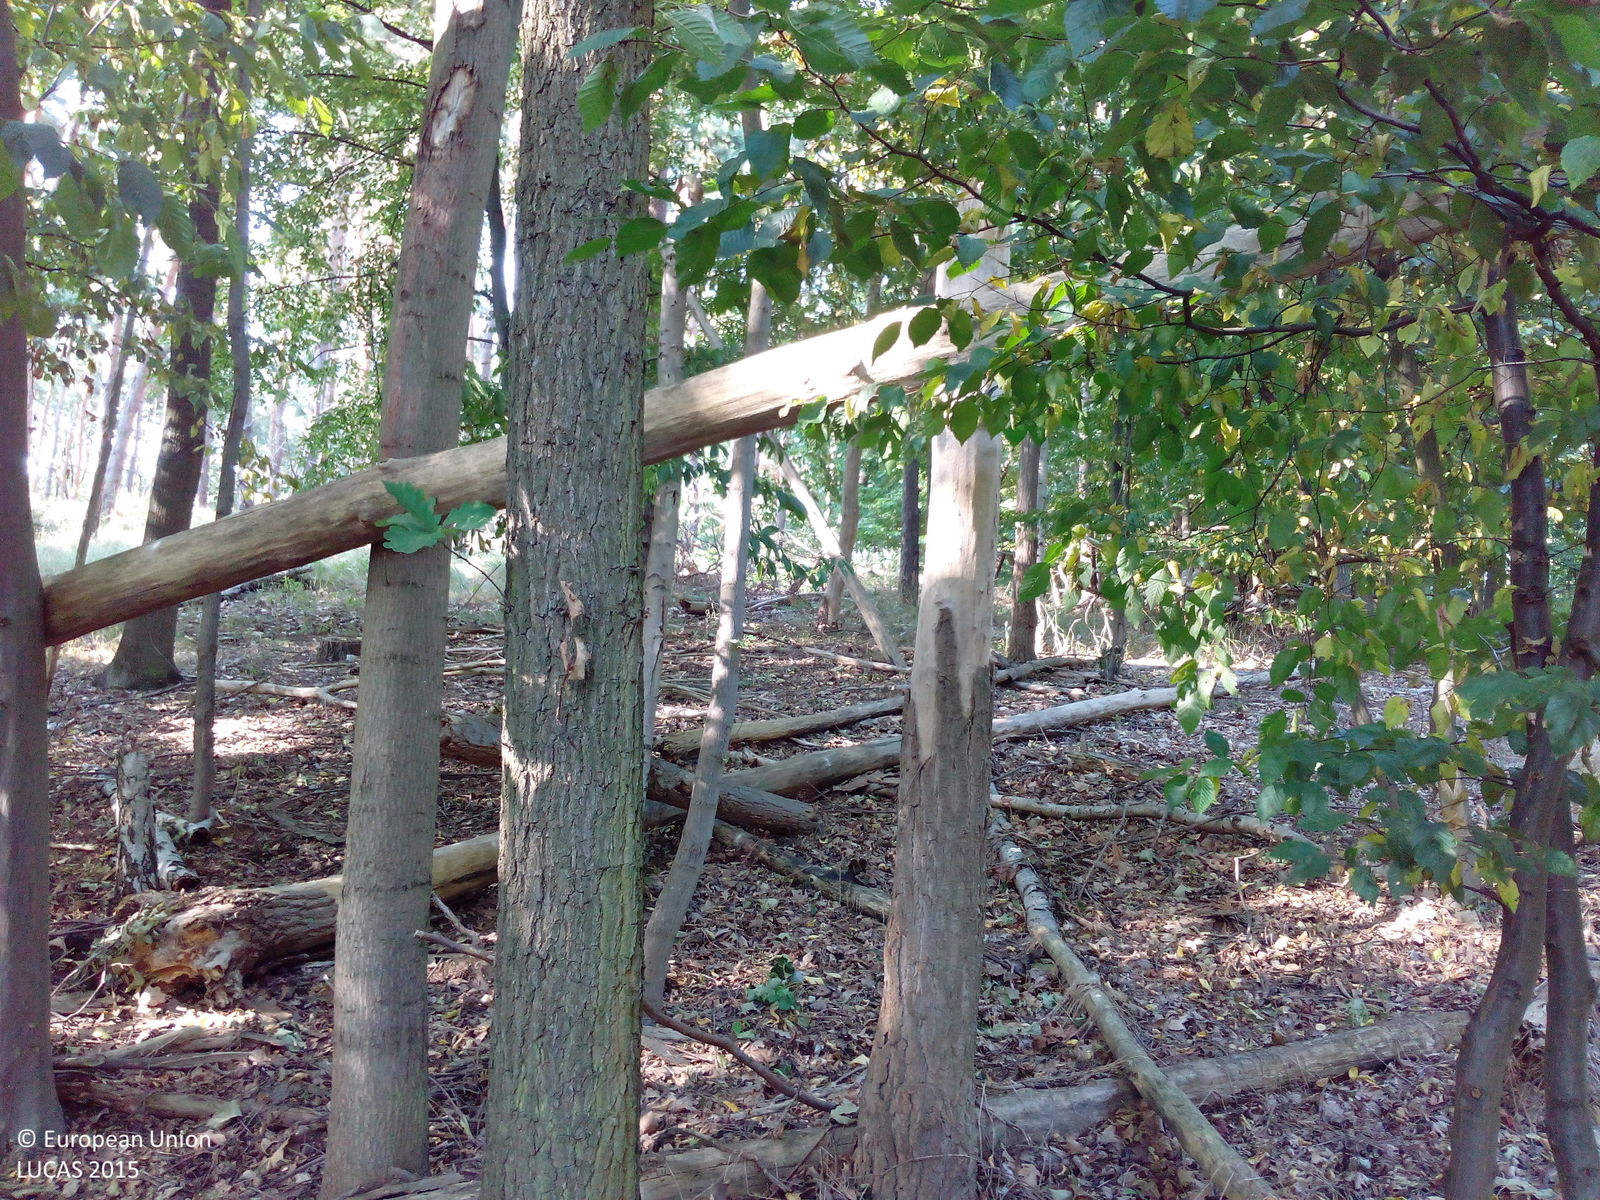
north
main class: Woodland
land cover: Broadleaved woodland
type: beech forest
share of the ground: > 75 %
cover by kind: broadleaved forest trees 90 %, shrubs 5 %, unconsolidated bare surface 5 %
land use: Forestry
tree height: > 5 m
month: August
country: DE
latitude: 51.8509
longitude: 11.1175
